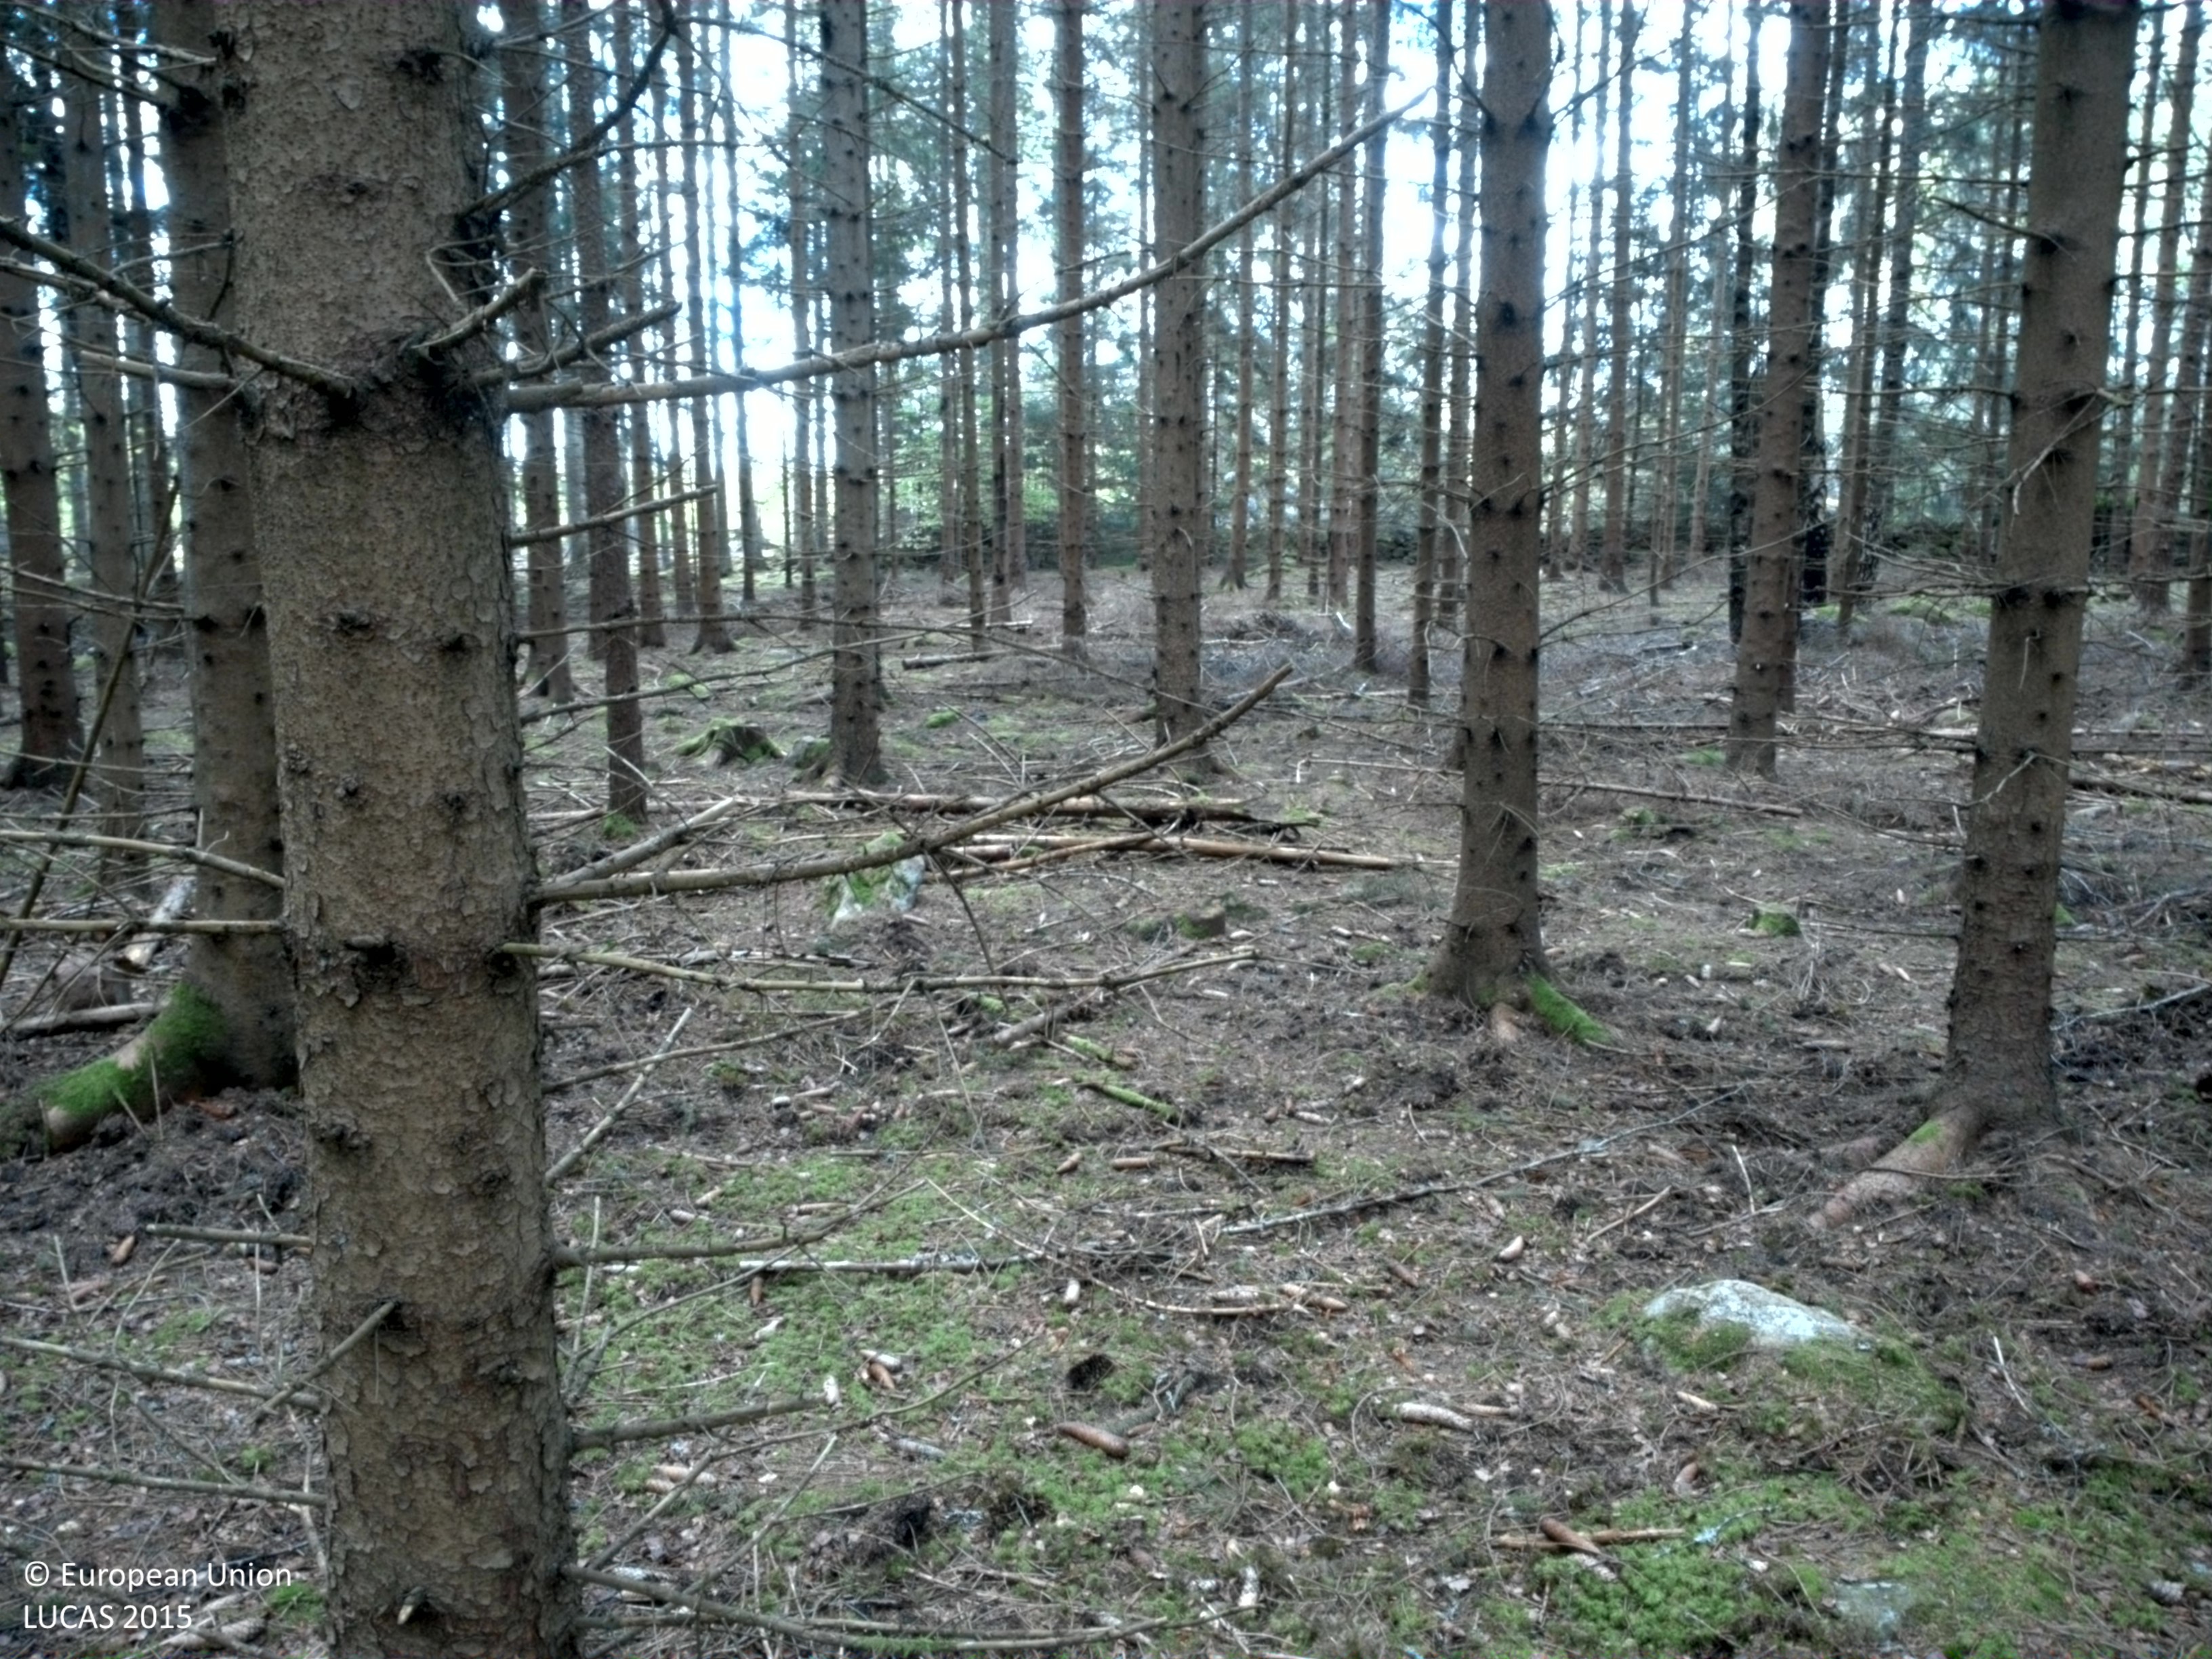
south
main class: Woodland
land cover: Spruce dominated coniferous woodland
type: boreal forest
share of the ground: > 75 %
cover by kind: coniferous forest trees 95 %, broadleaved forest trees 5 %
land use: Forestry
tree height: > 5 m
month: May
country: SE
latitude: 56.4884
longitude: 15.4069
